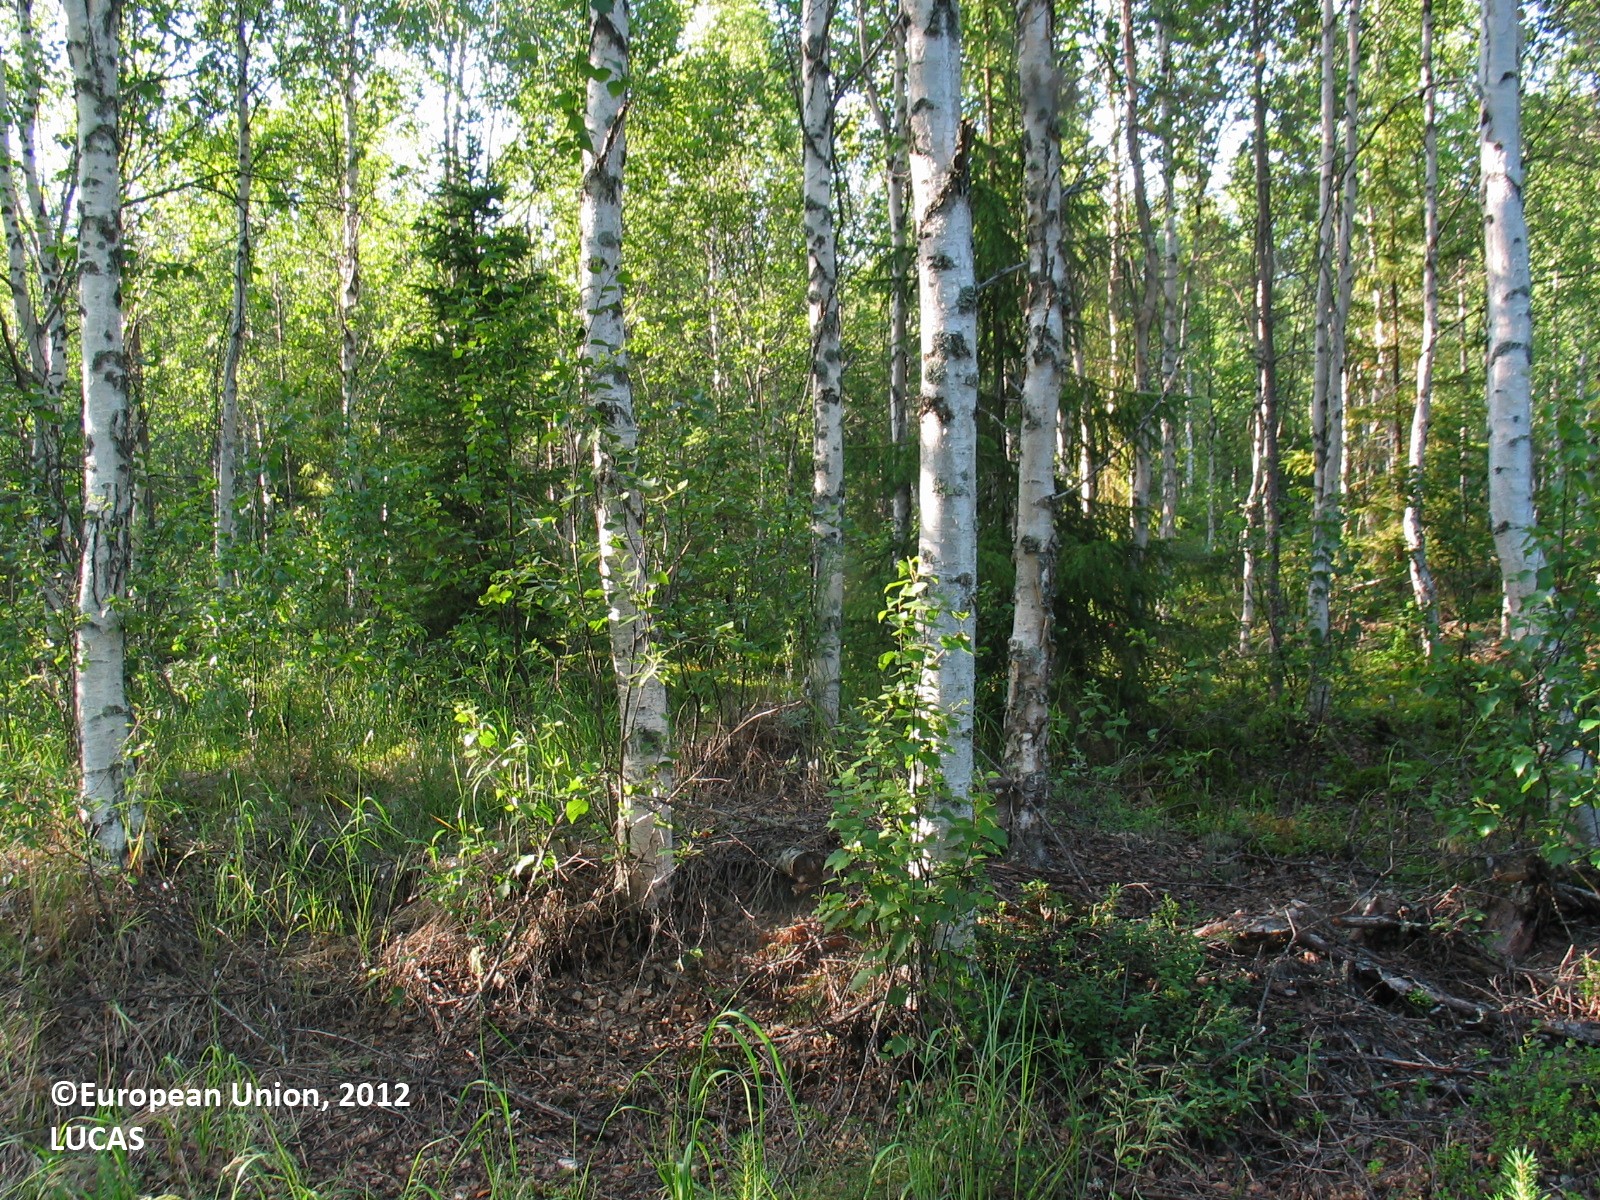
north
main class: Woodland
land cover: Broadleaved woodland
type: boreal forest
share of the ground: 25 - 50 %
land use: Forestry
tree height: > 5 m
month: July
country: FI
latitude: 65.7983
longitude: 24.8602
